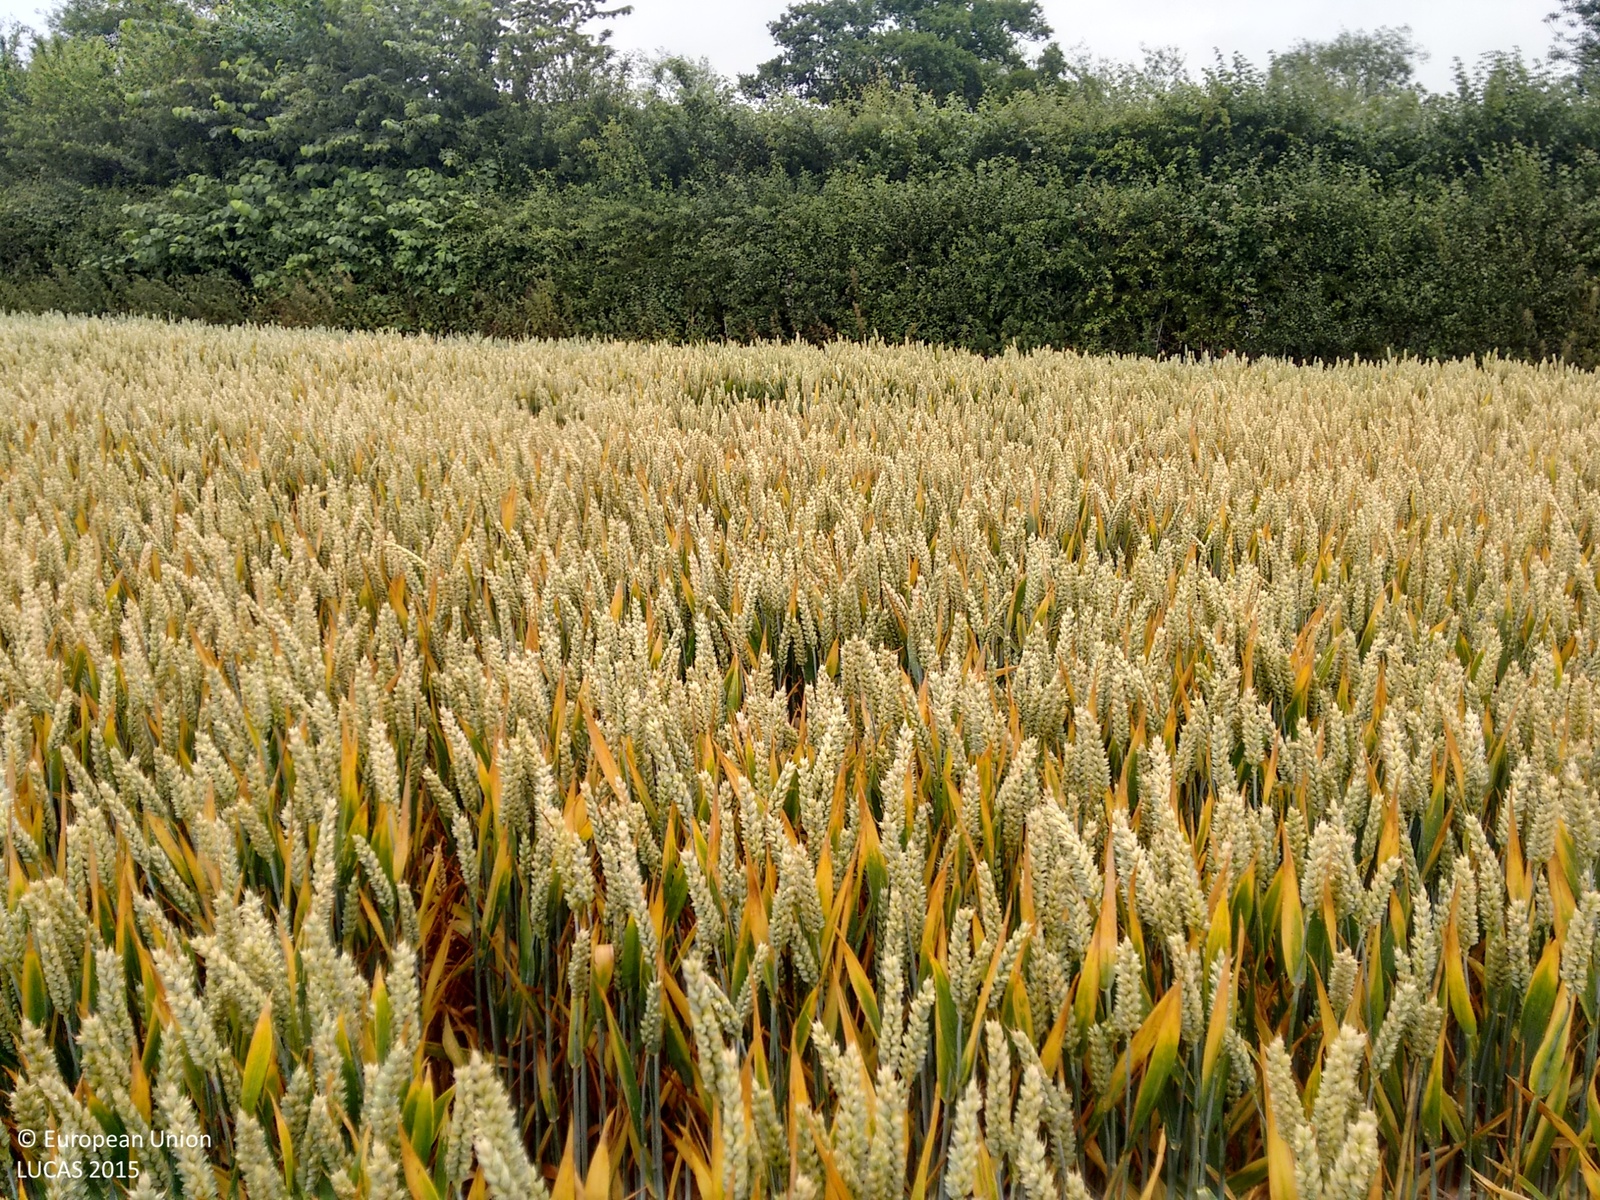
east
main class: Cropland
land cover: Common wheat
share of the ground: > 75 %
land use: Agriculture (excluding fallow land and kitchen gardens)
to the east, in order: Common wheat; Grass margins; Managed hedges; Artificial constructions in urban areas; Fences; Grassland without tree/shrub cover; Broadleaved woodland; Fences; Grass margins; Common wheat; Managed hedges; Grassland without tree/shrub cover
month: July
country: GB
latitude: 52.2601
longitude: -2.8331
